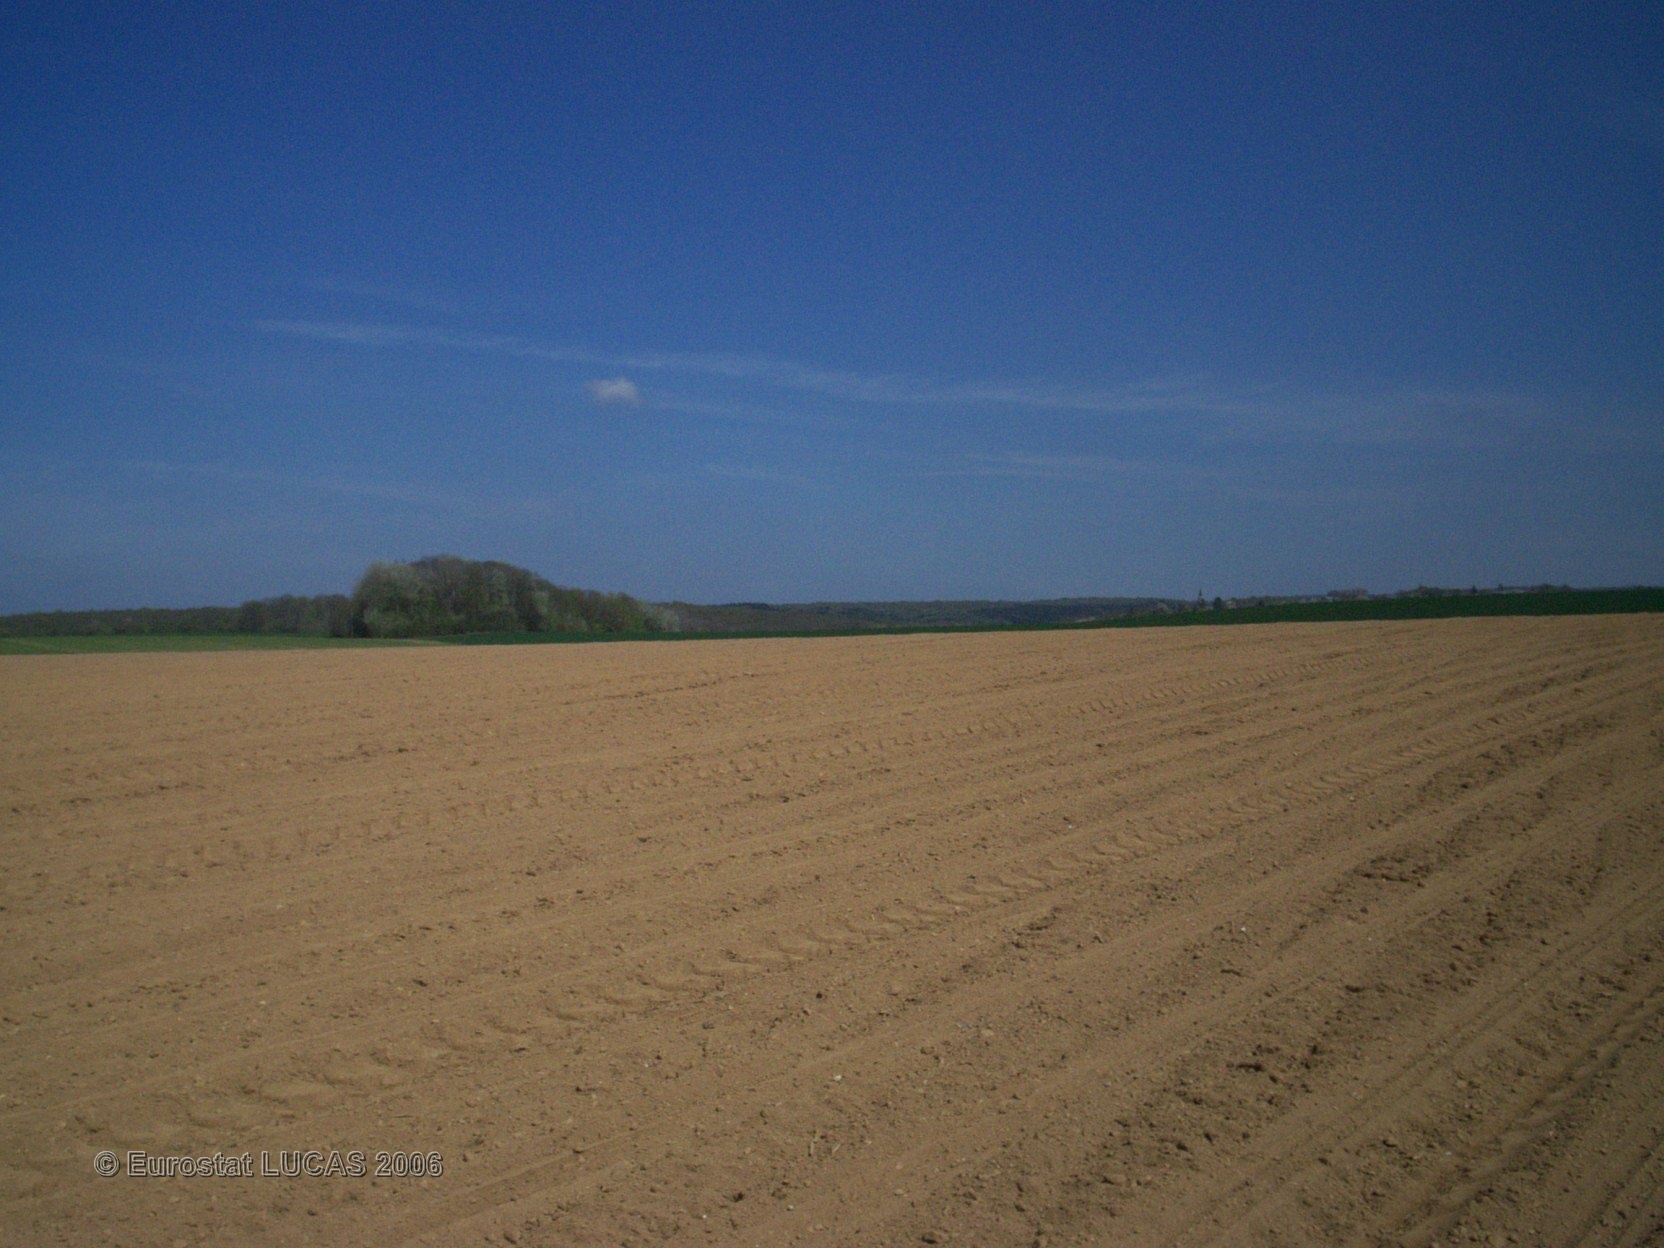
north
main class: Cropland
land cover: Maize
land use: Agriculture (excluding fallow land and kitchen gardens)
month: April
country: FR
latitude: 49.6315
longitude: 4.3885
